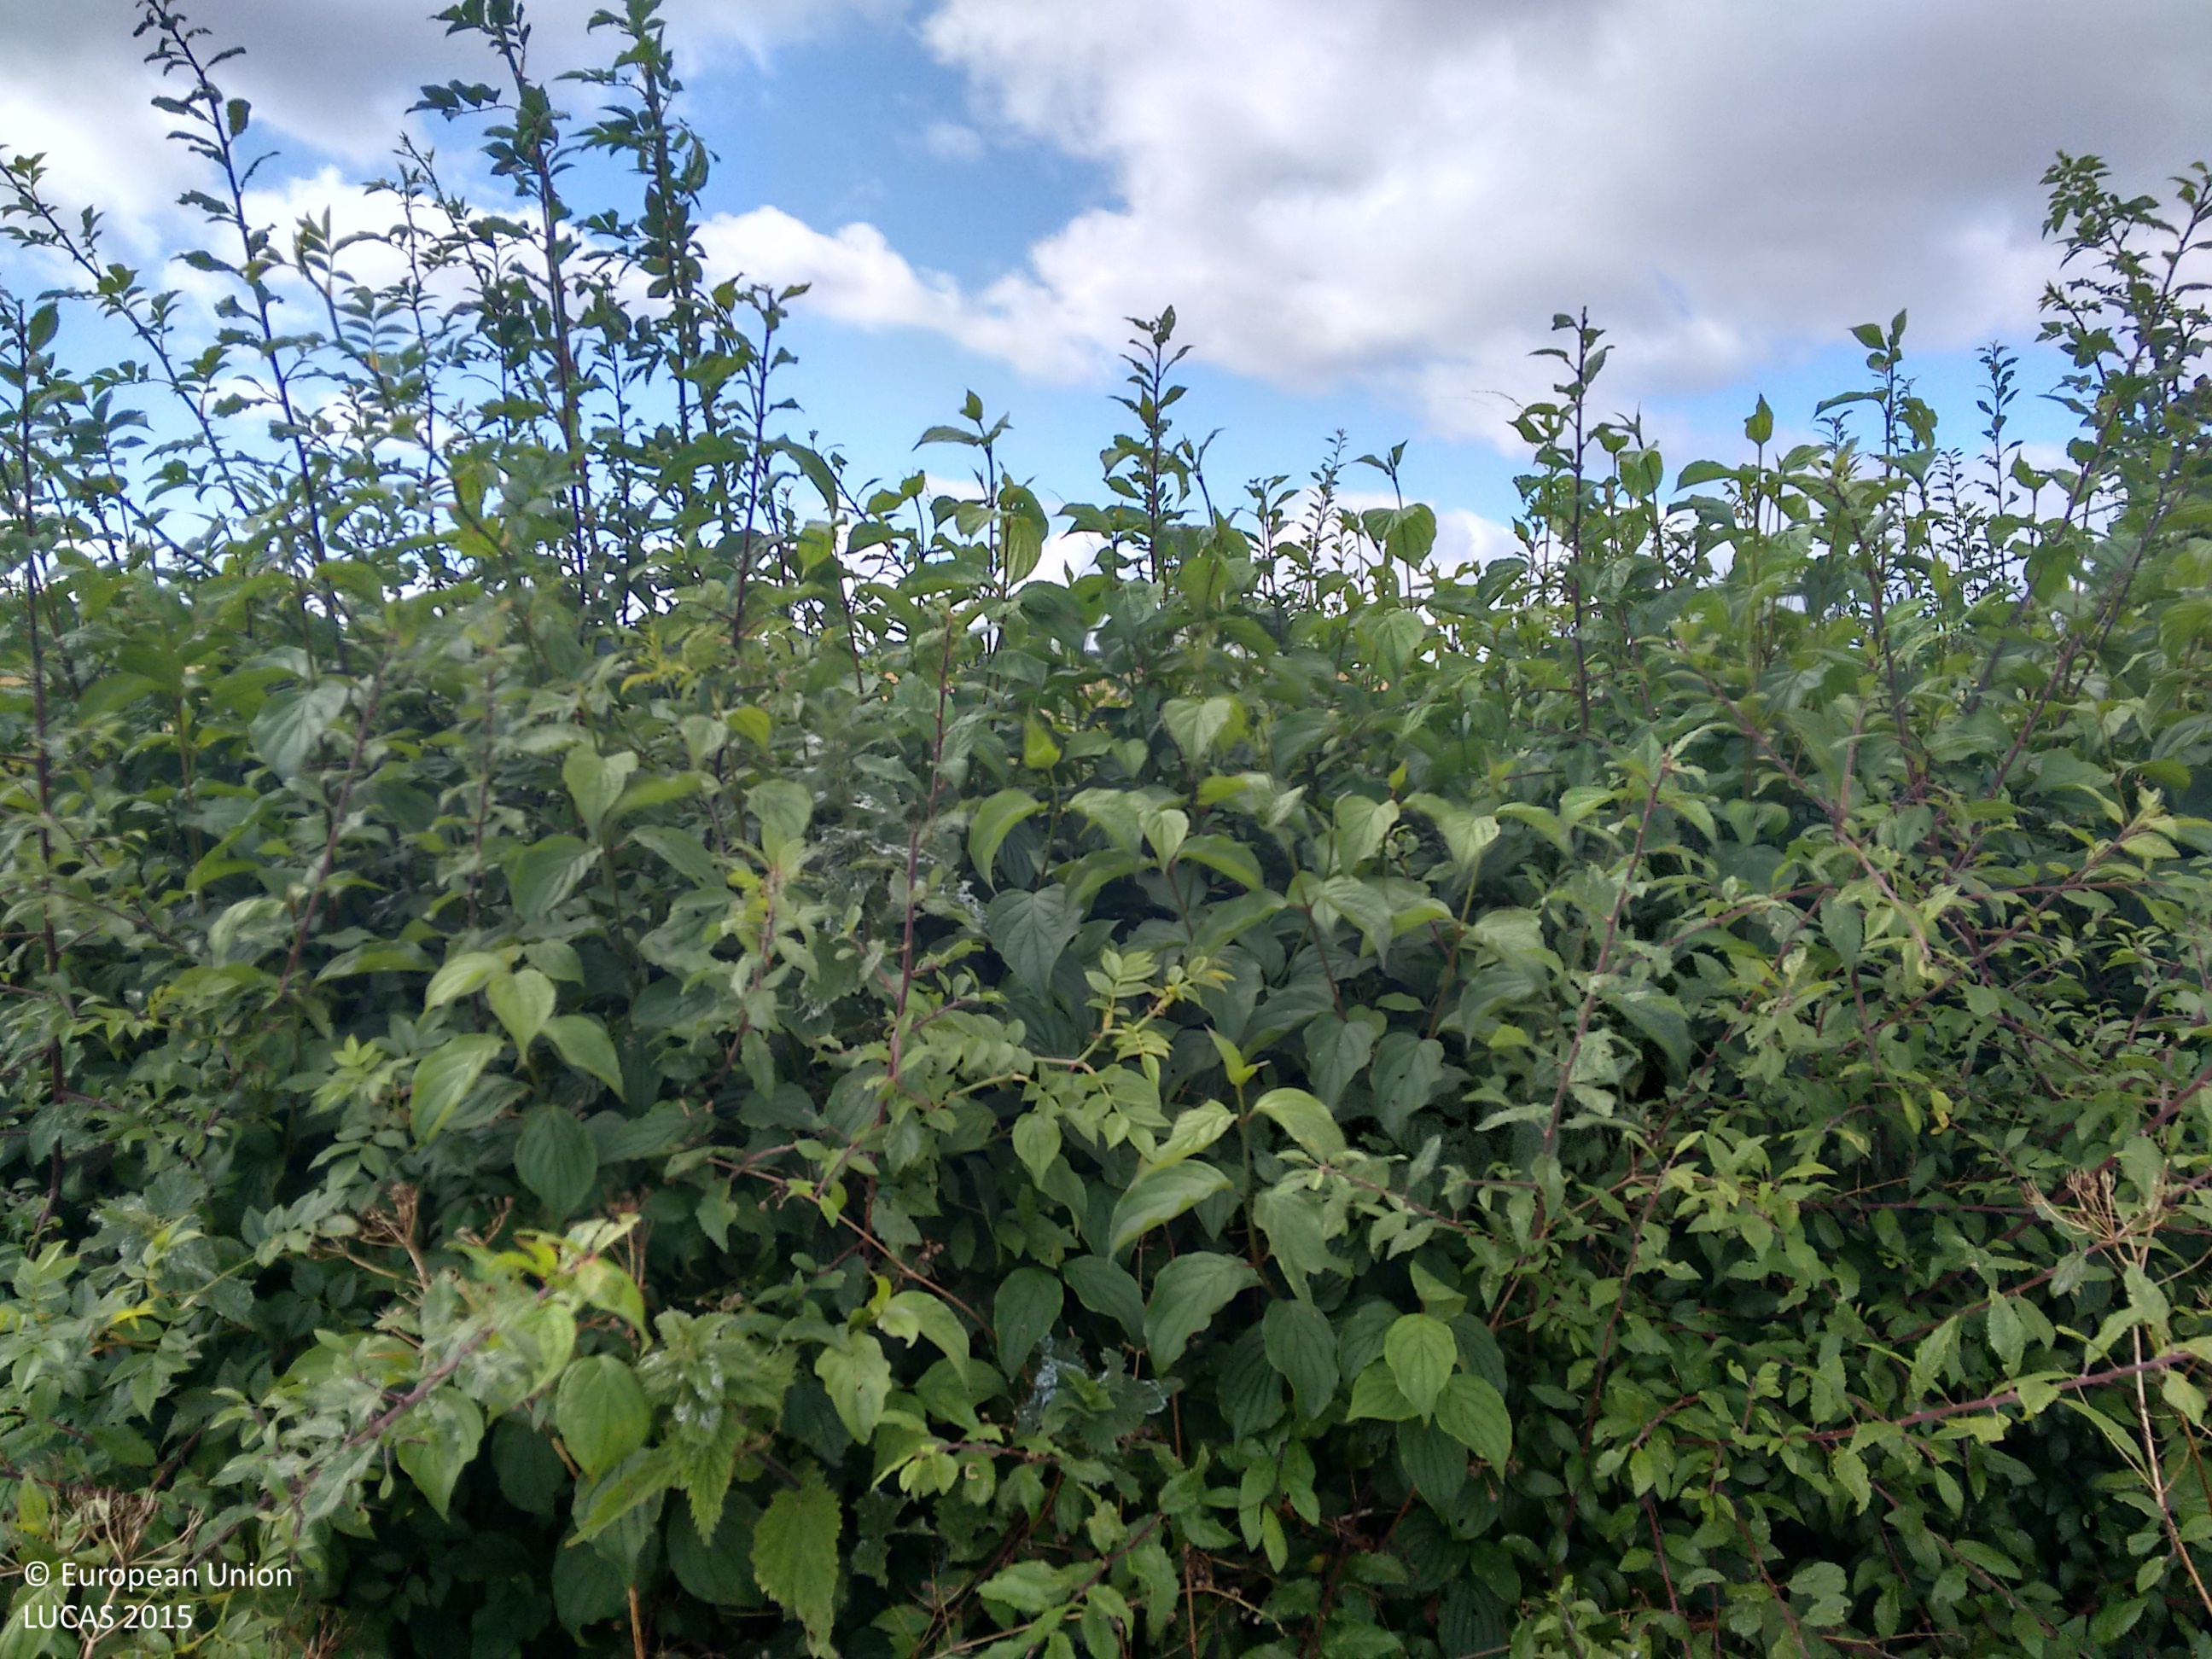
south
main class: Cropland
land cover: Rape and turnip rape
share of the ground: > 75 %
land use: Agriculture (excluding fallow land and kitchen gardens)
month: July
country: GB
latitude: 51.3601
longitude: -2.4013
